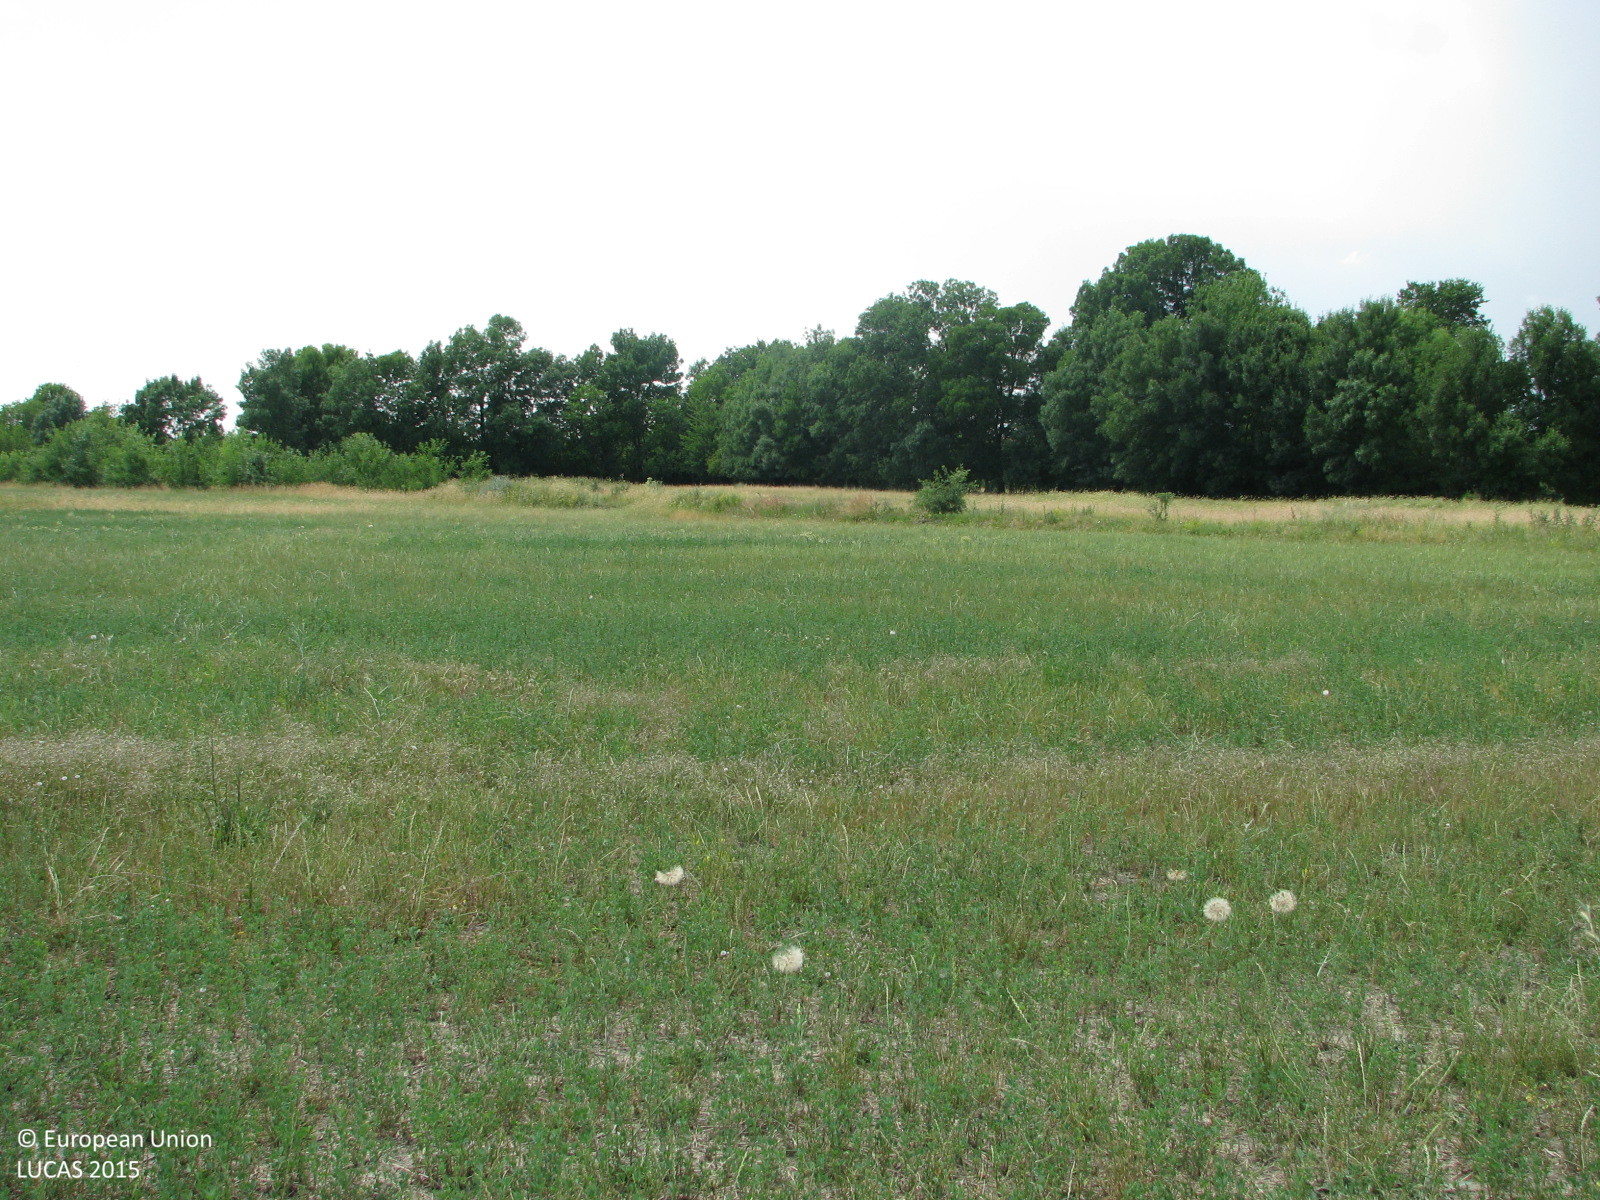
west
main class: Cropland
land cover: Lucerne
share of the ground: > 75 %
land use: Agriculture (excluding fallow land and kitchen gardens)
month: June
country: BG
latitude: 42.6254
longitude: 26.5432
